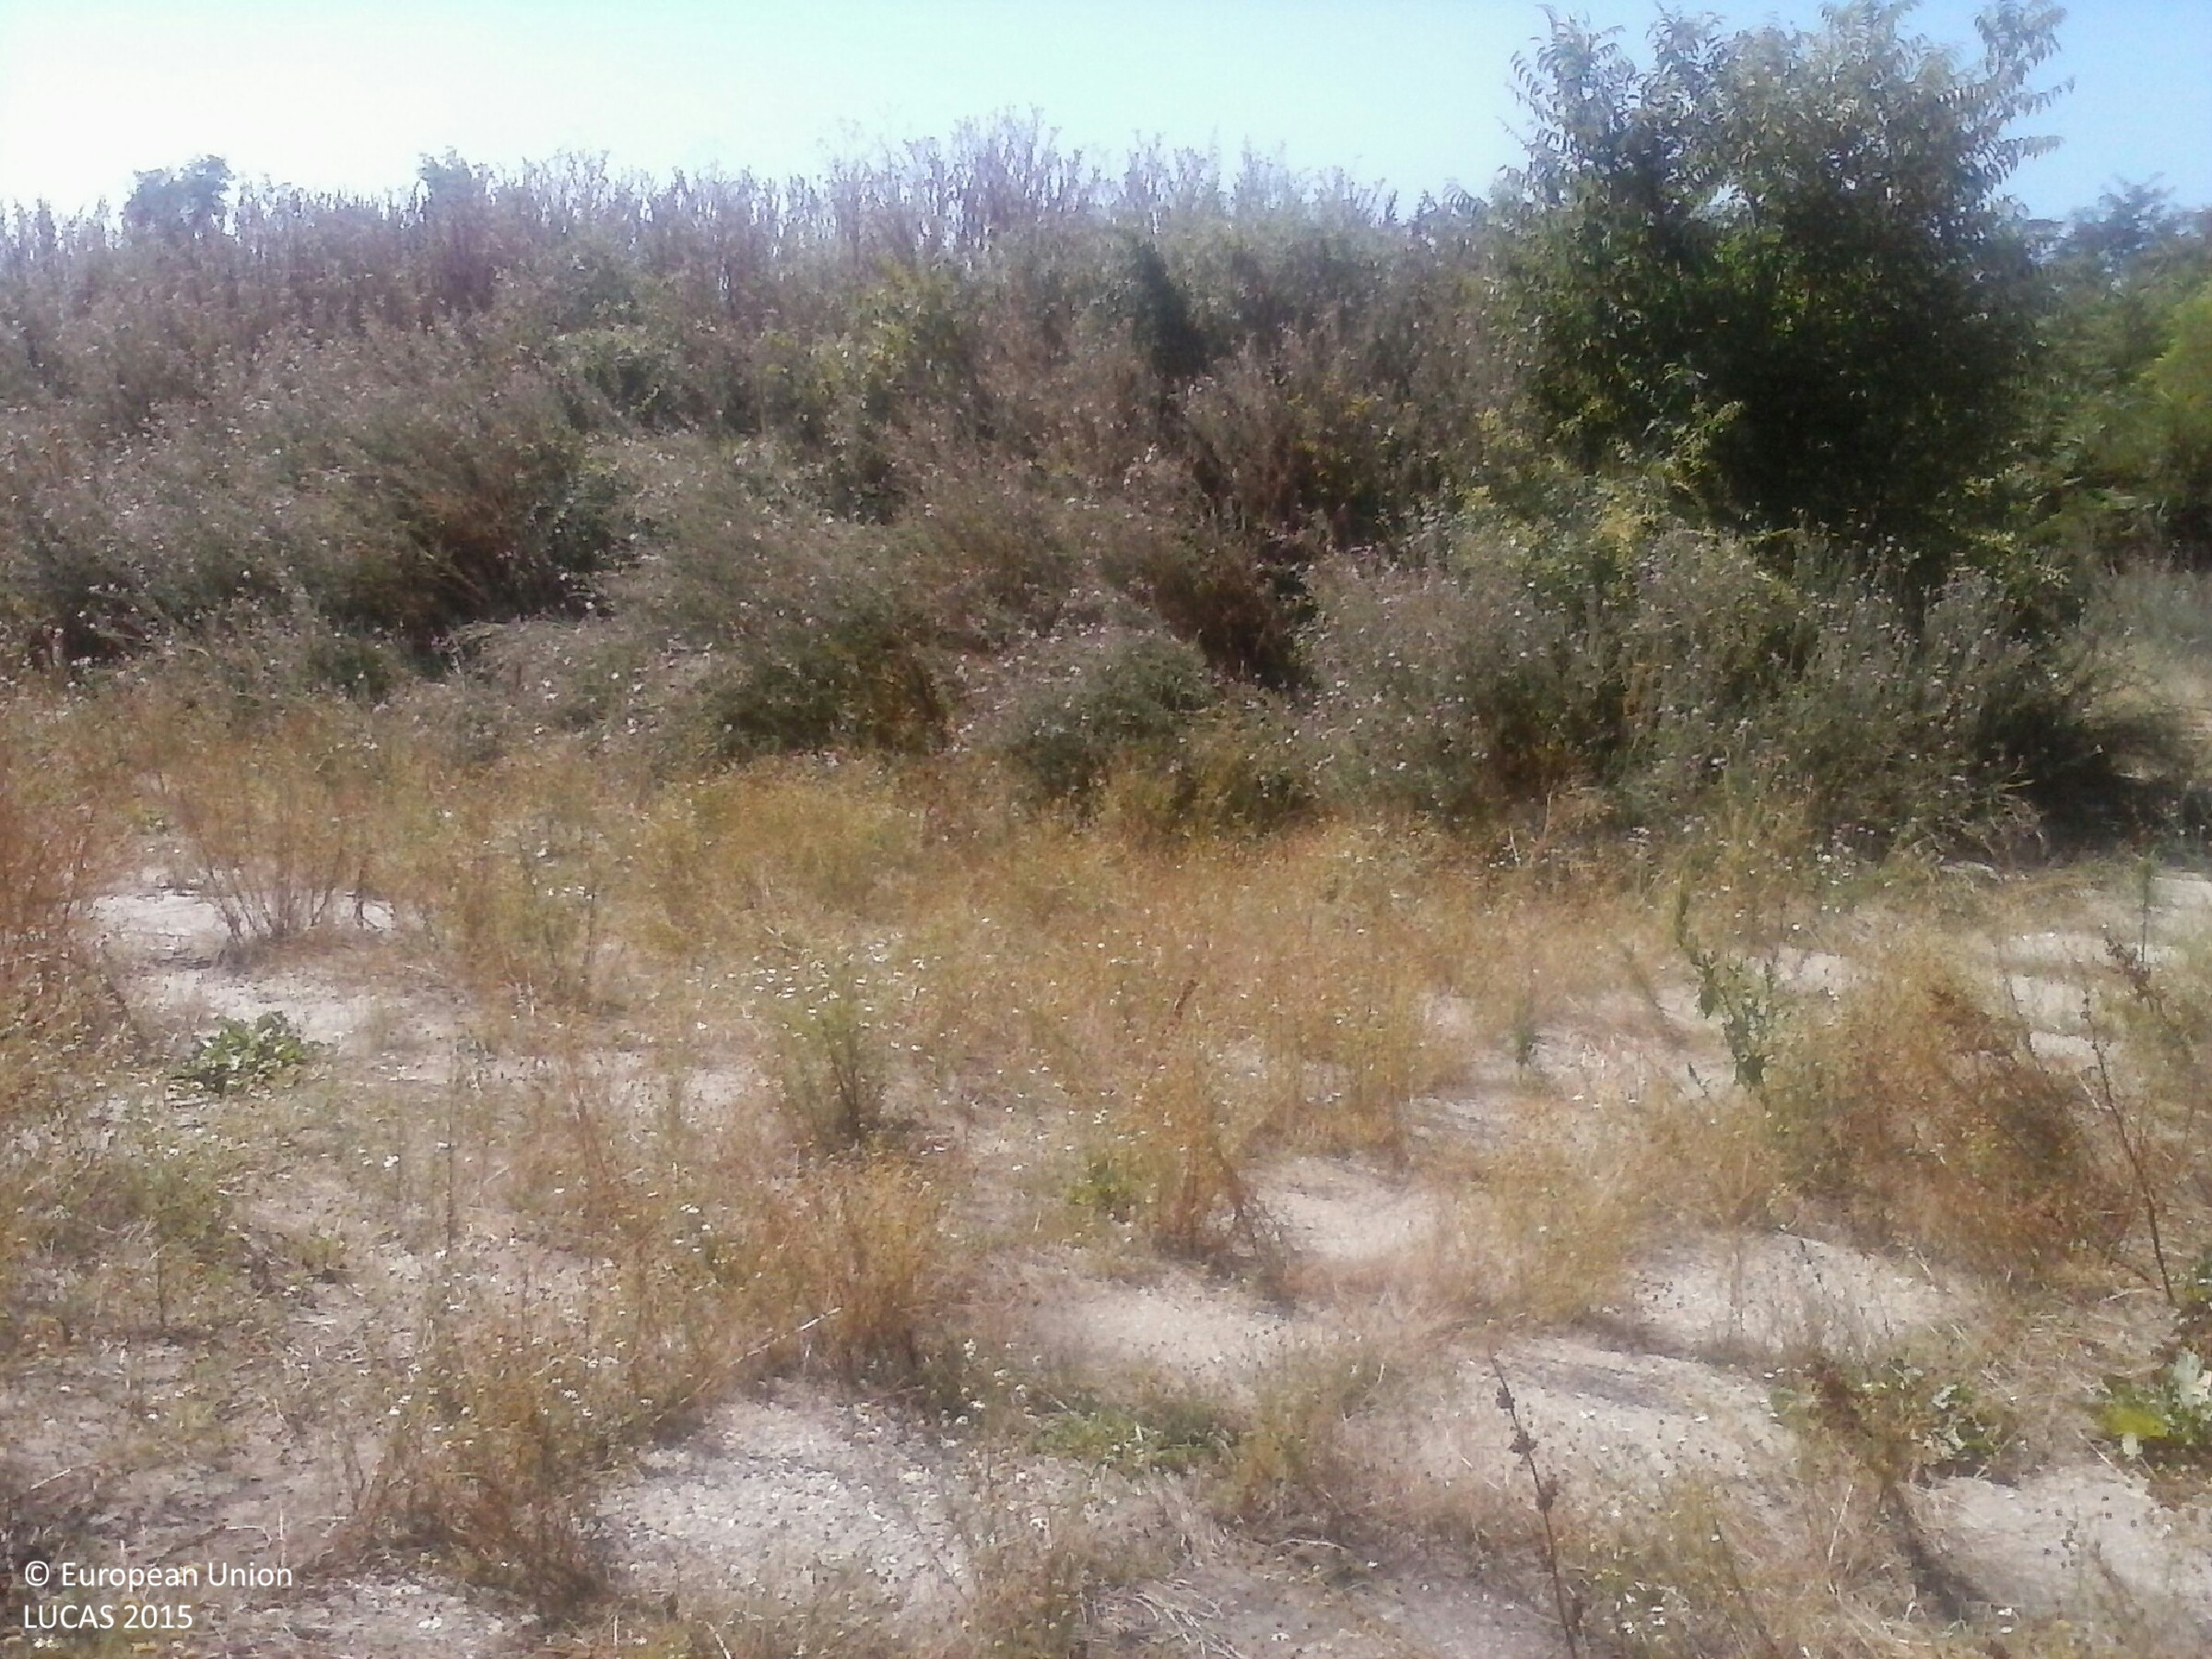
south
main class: Grassland
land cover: Spontaneously vegetated surfaces
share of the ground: 50 - 75 %
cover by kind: herbaceous plants 70 %, unconsolidated bare surface 30 %
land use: Abandoned areas
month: July
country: HU
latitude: 46.6226
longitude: 20.4086
